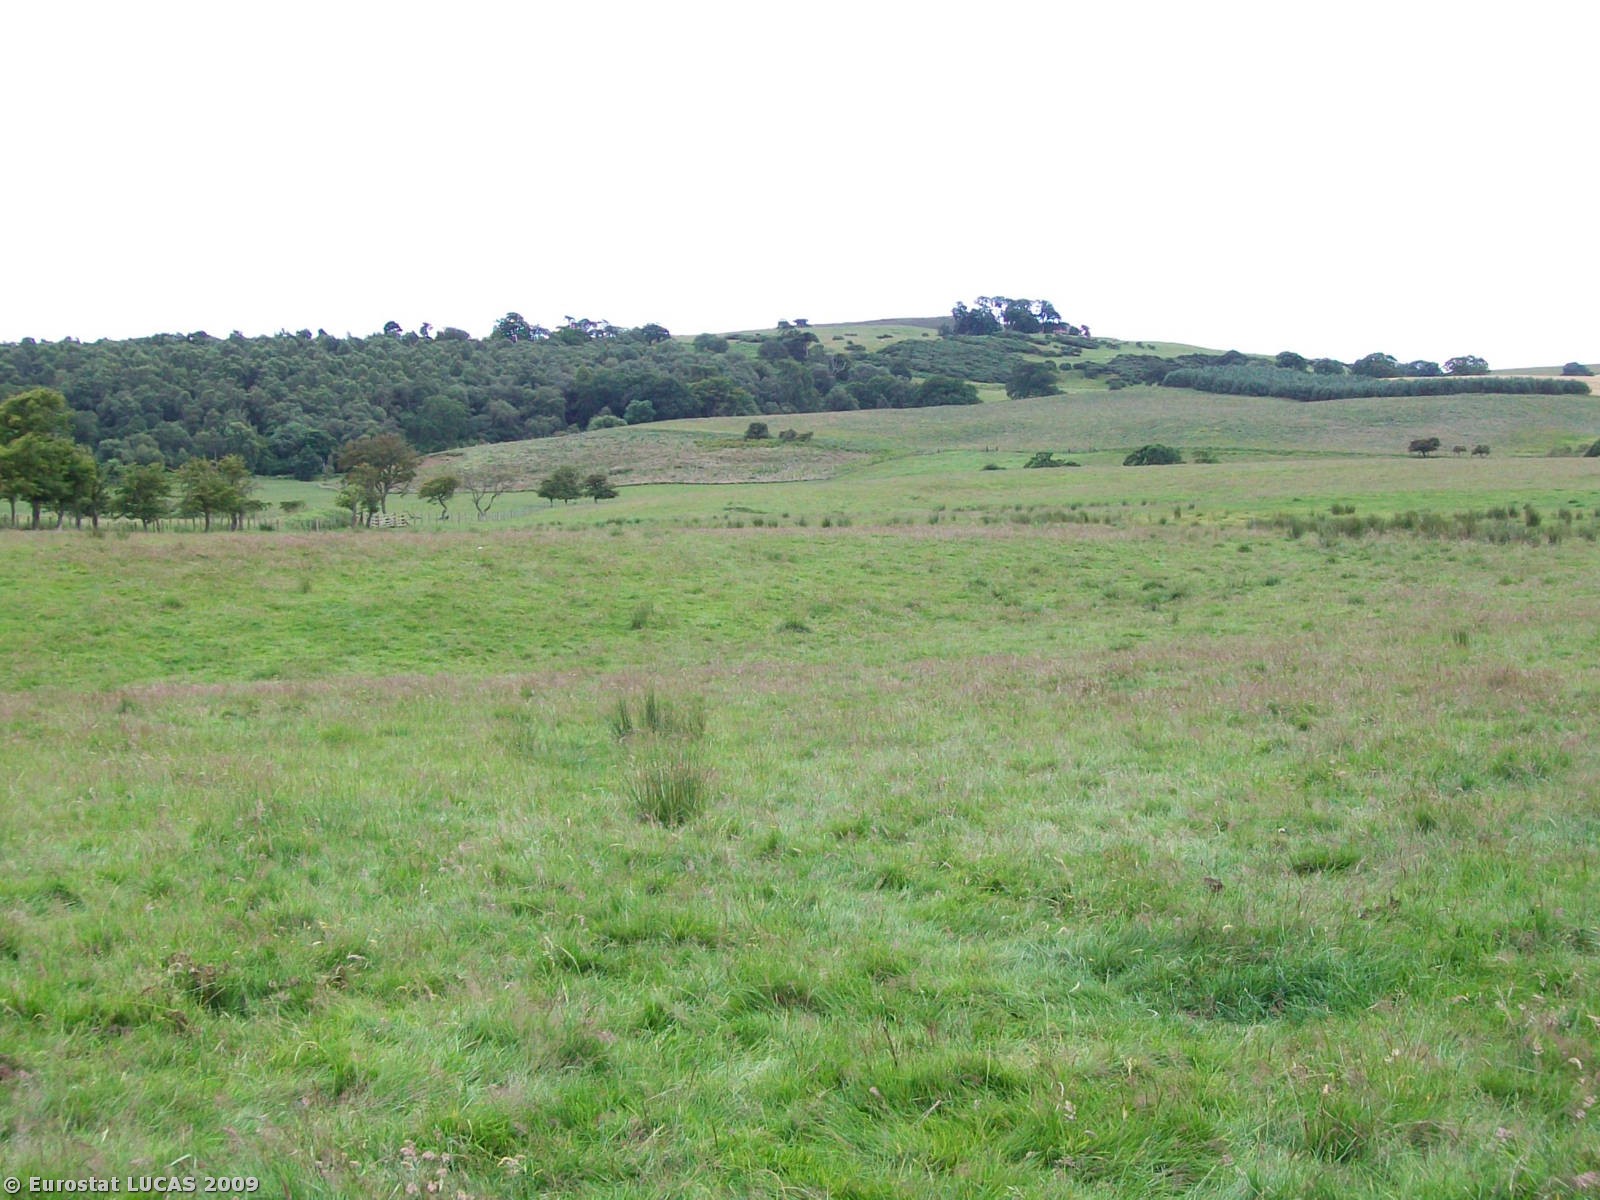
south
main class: Grassland
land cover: Grassland without tree/shrub cover
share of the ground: > 75 %
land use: Agriculture (excluding fallow land and kitchen gardens)
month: July
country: GB
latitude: 55.4533
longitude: -1.8627
